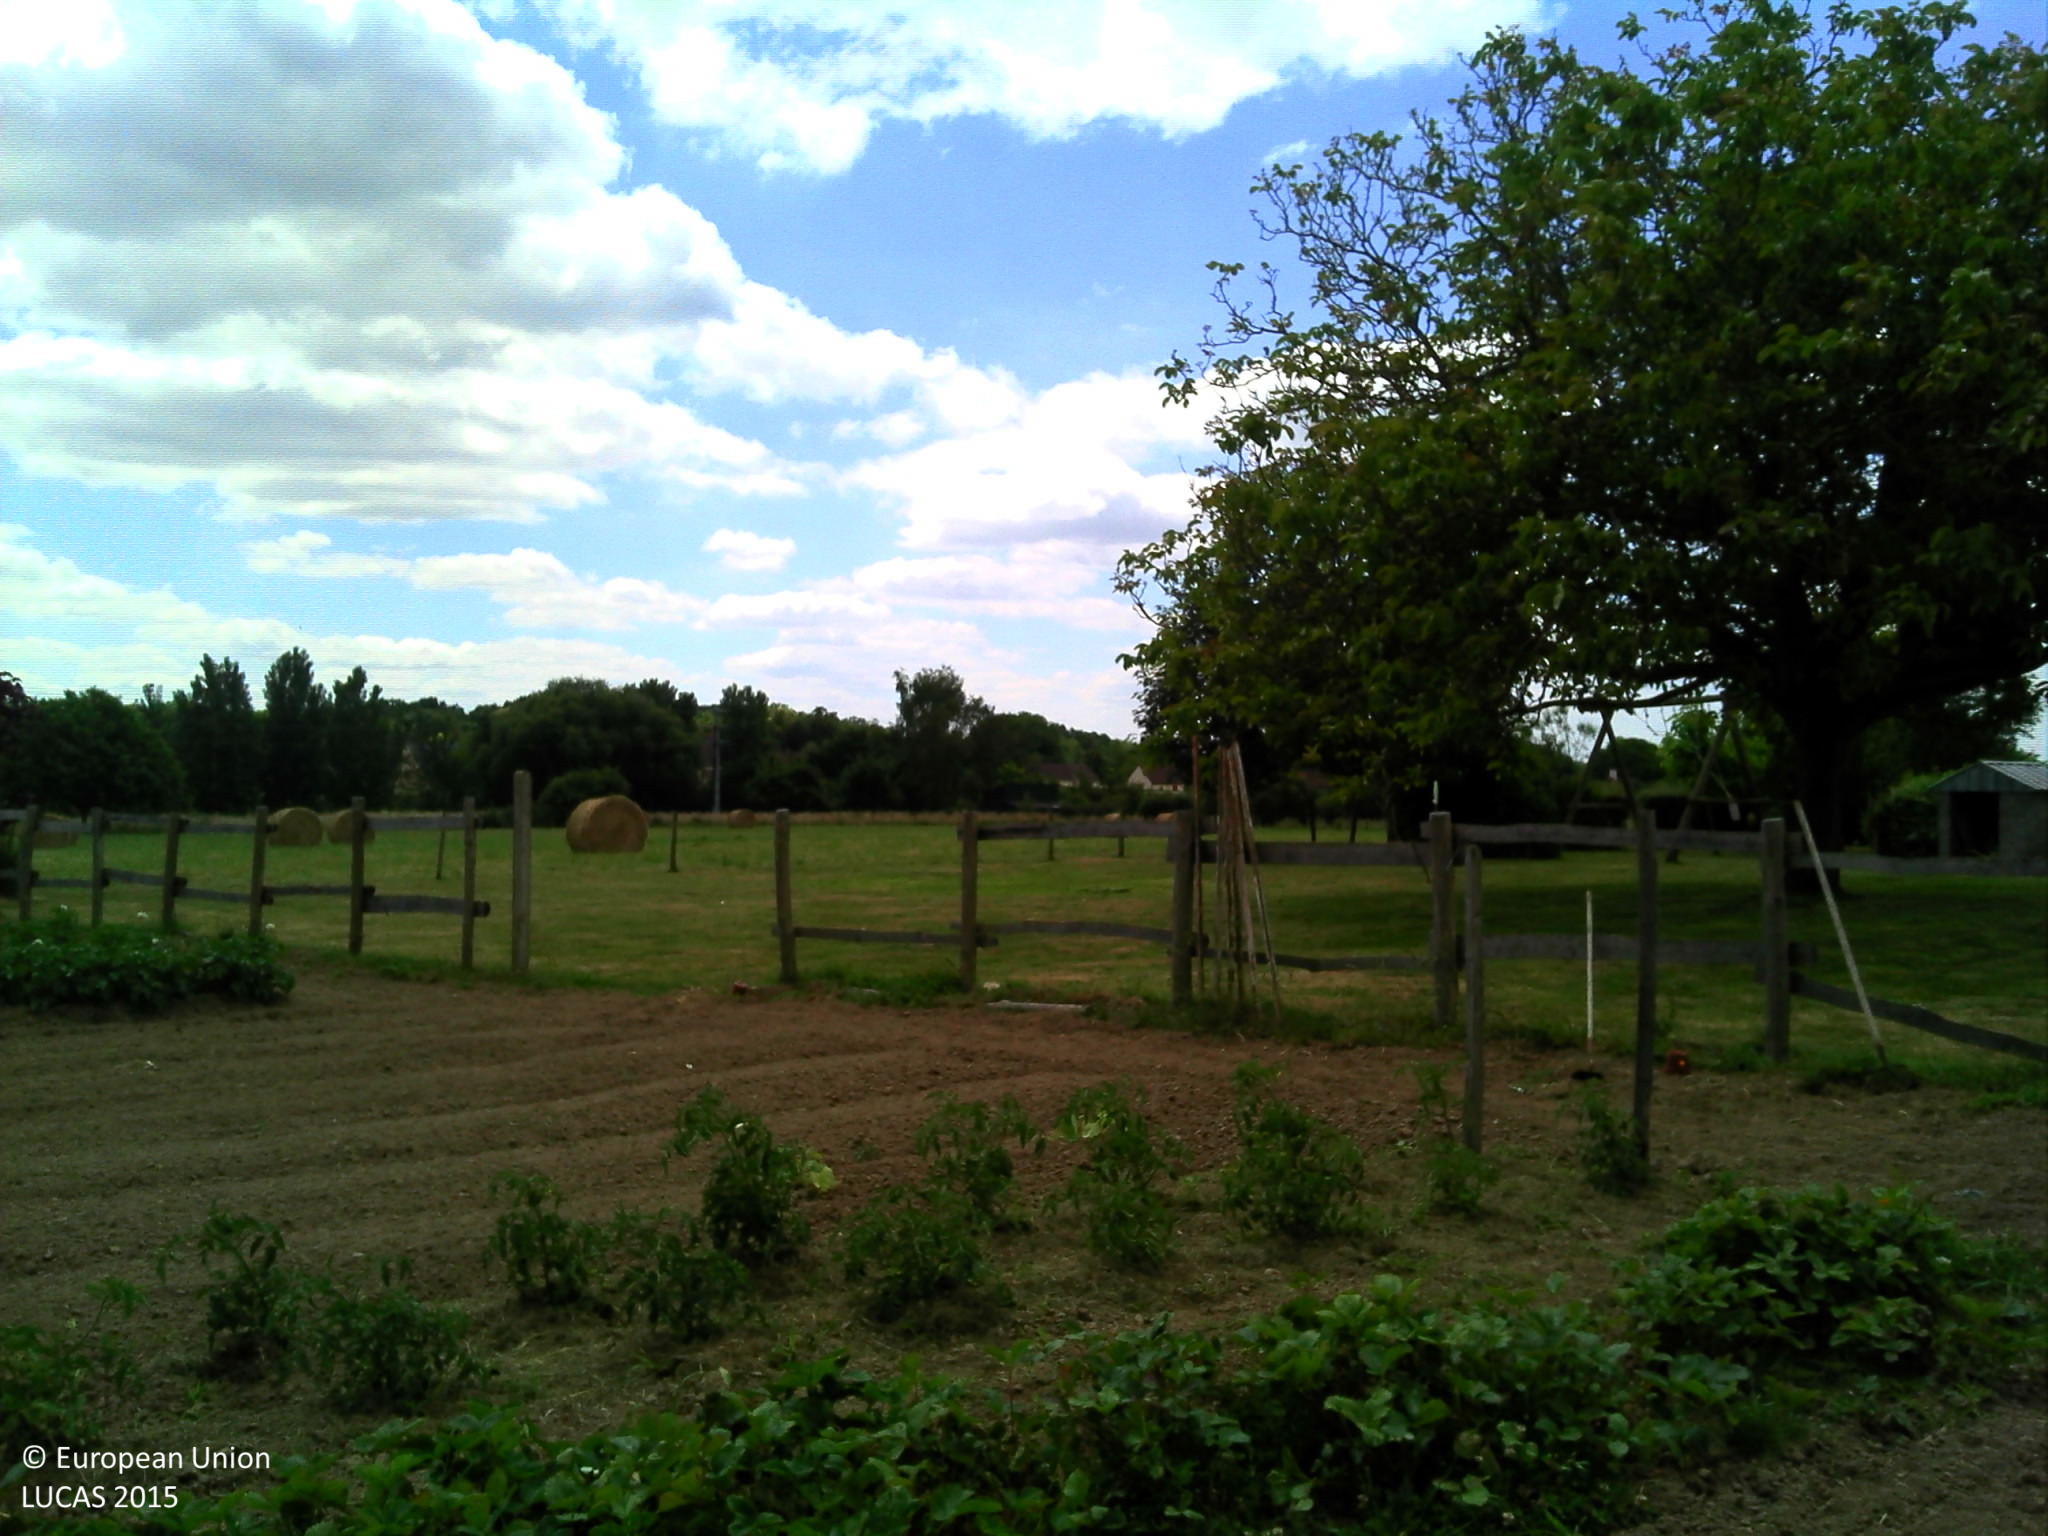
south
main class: Cropland
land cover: Potatoes
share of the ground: > 75 %
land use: Kitchen garden
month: June
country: FR
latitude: 47.8279
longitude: 0.2637
